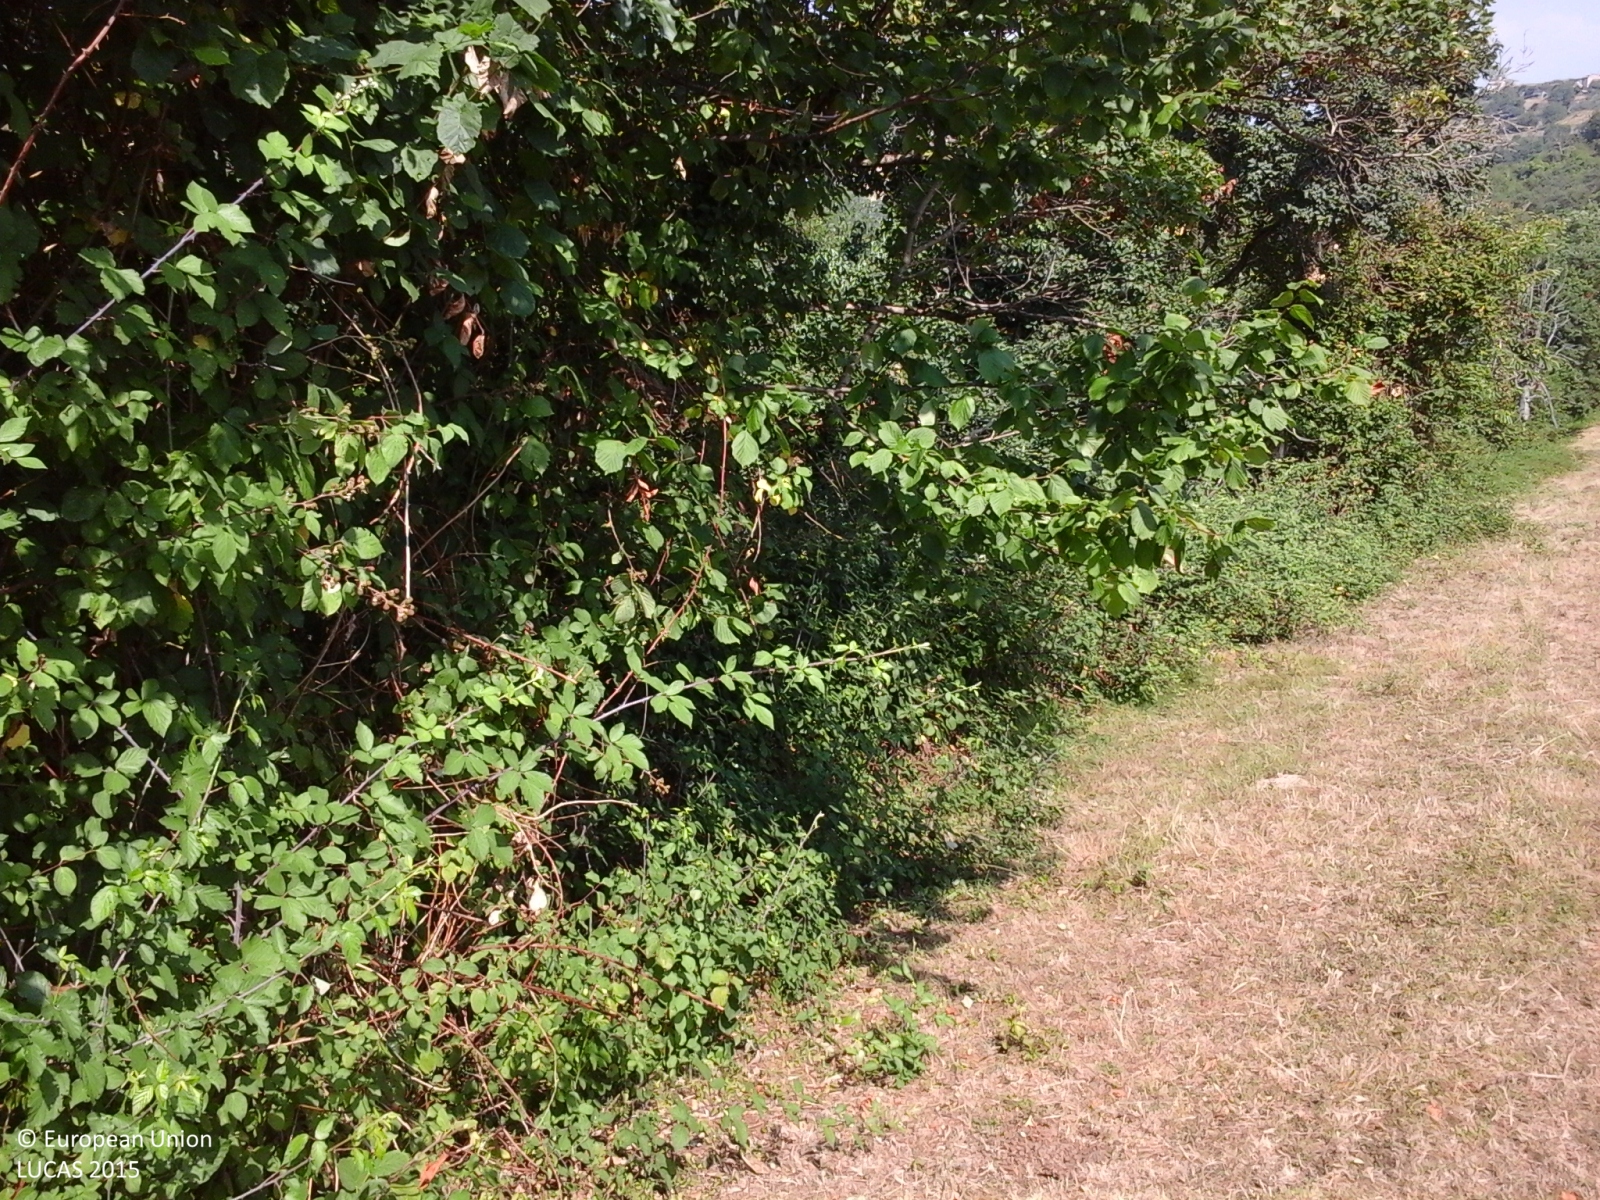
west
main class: Grassland
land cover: Grassland without tree/shrub cover
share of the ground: > 75 %
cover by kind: herbaceous plants 100 %
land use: Agriculture (excluding fallow land and kitchen gardens)
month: July
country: IT
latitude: 45.5346
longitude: 11.1122
